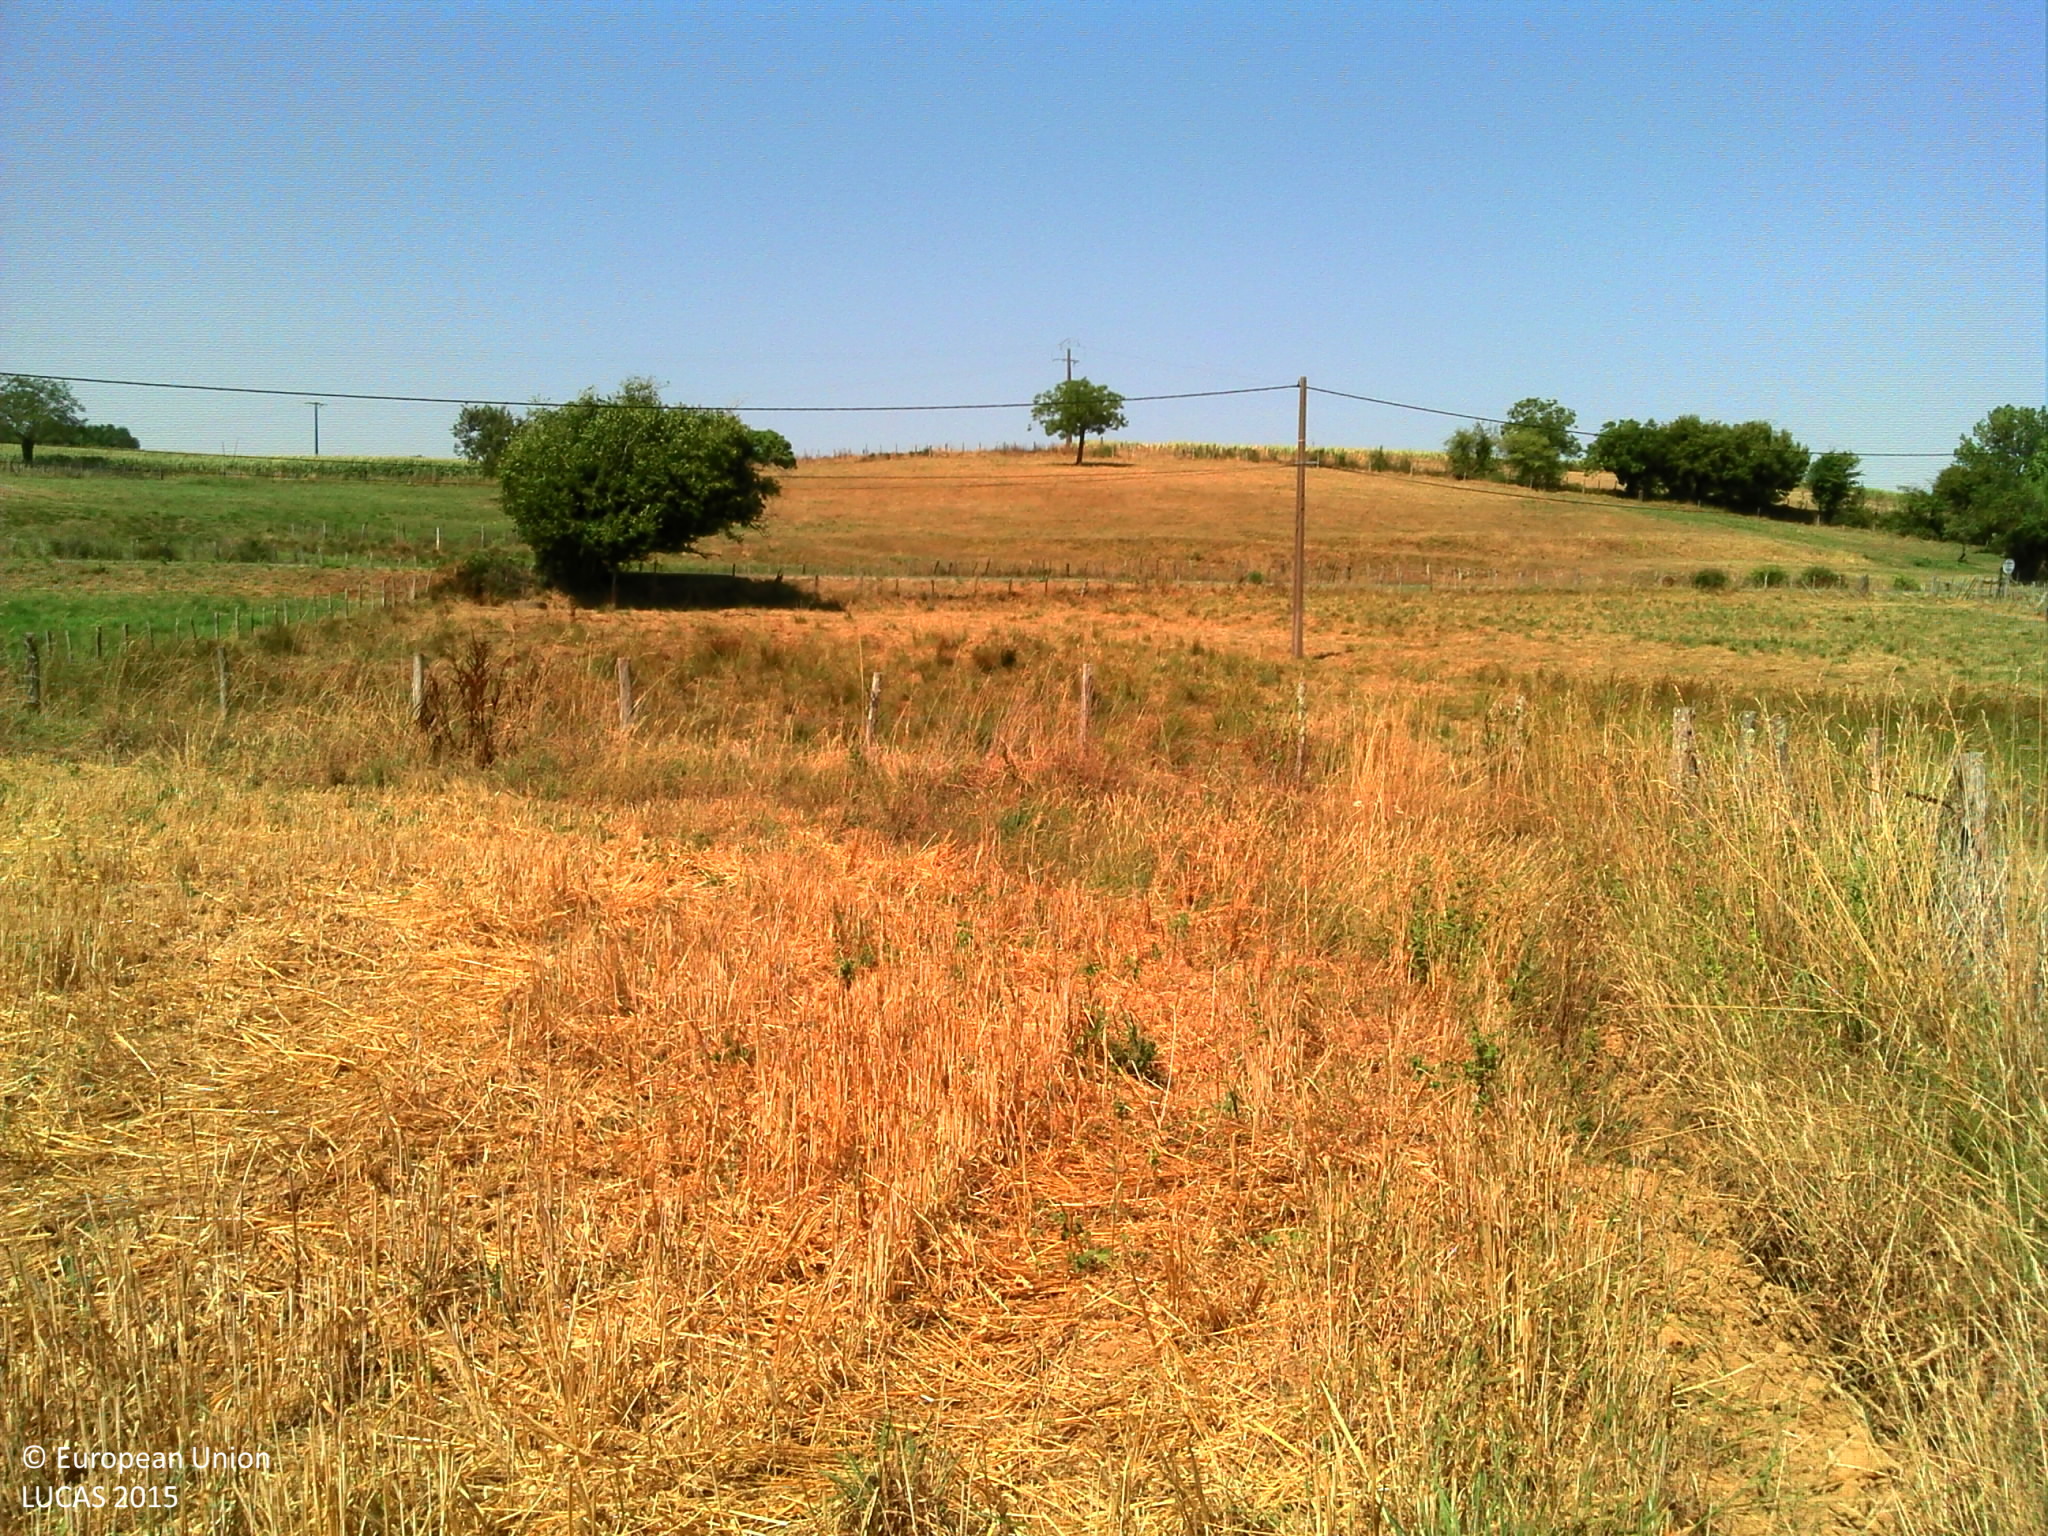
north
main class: Grassland
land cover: Grassland with sparse tree/shrub cover
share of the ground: > 75 %
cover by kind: herbaceous plants 90 %, broadleaved forest trees 5 %, unconsolidated bare surface 5 %
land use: Agriculture (excluding fallow land and kitchen gardens)
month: August
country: FR
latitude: 45.3787
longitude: 1.0651
